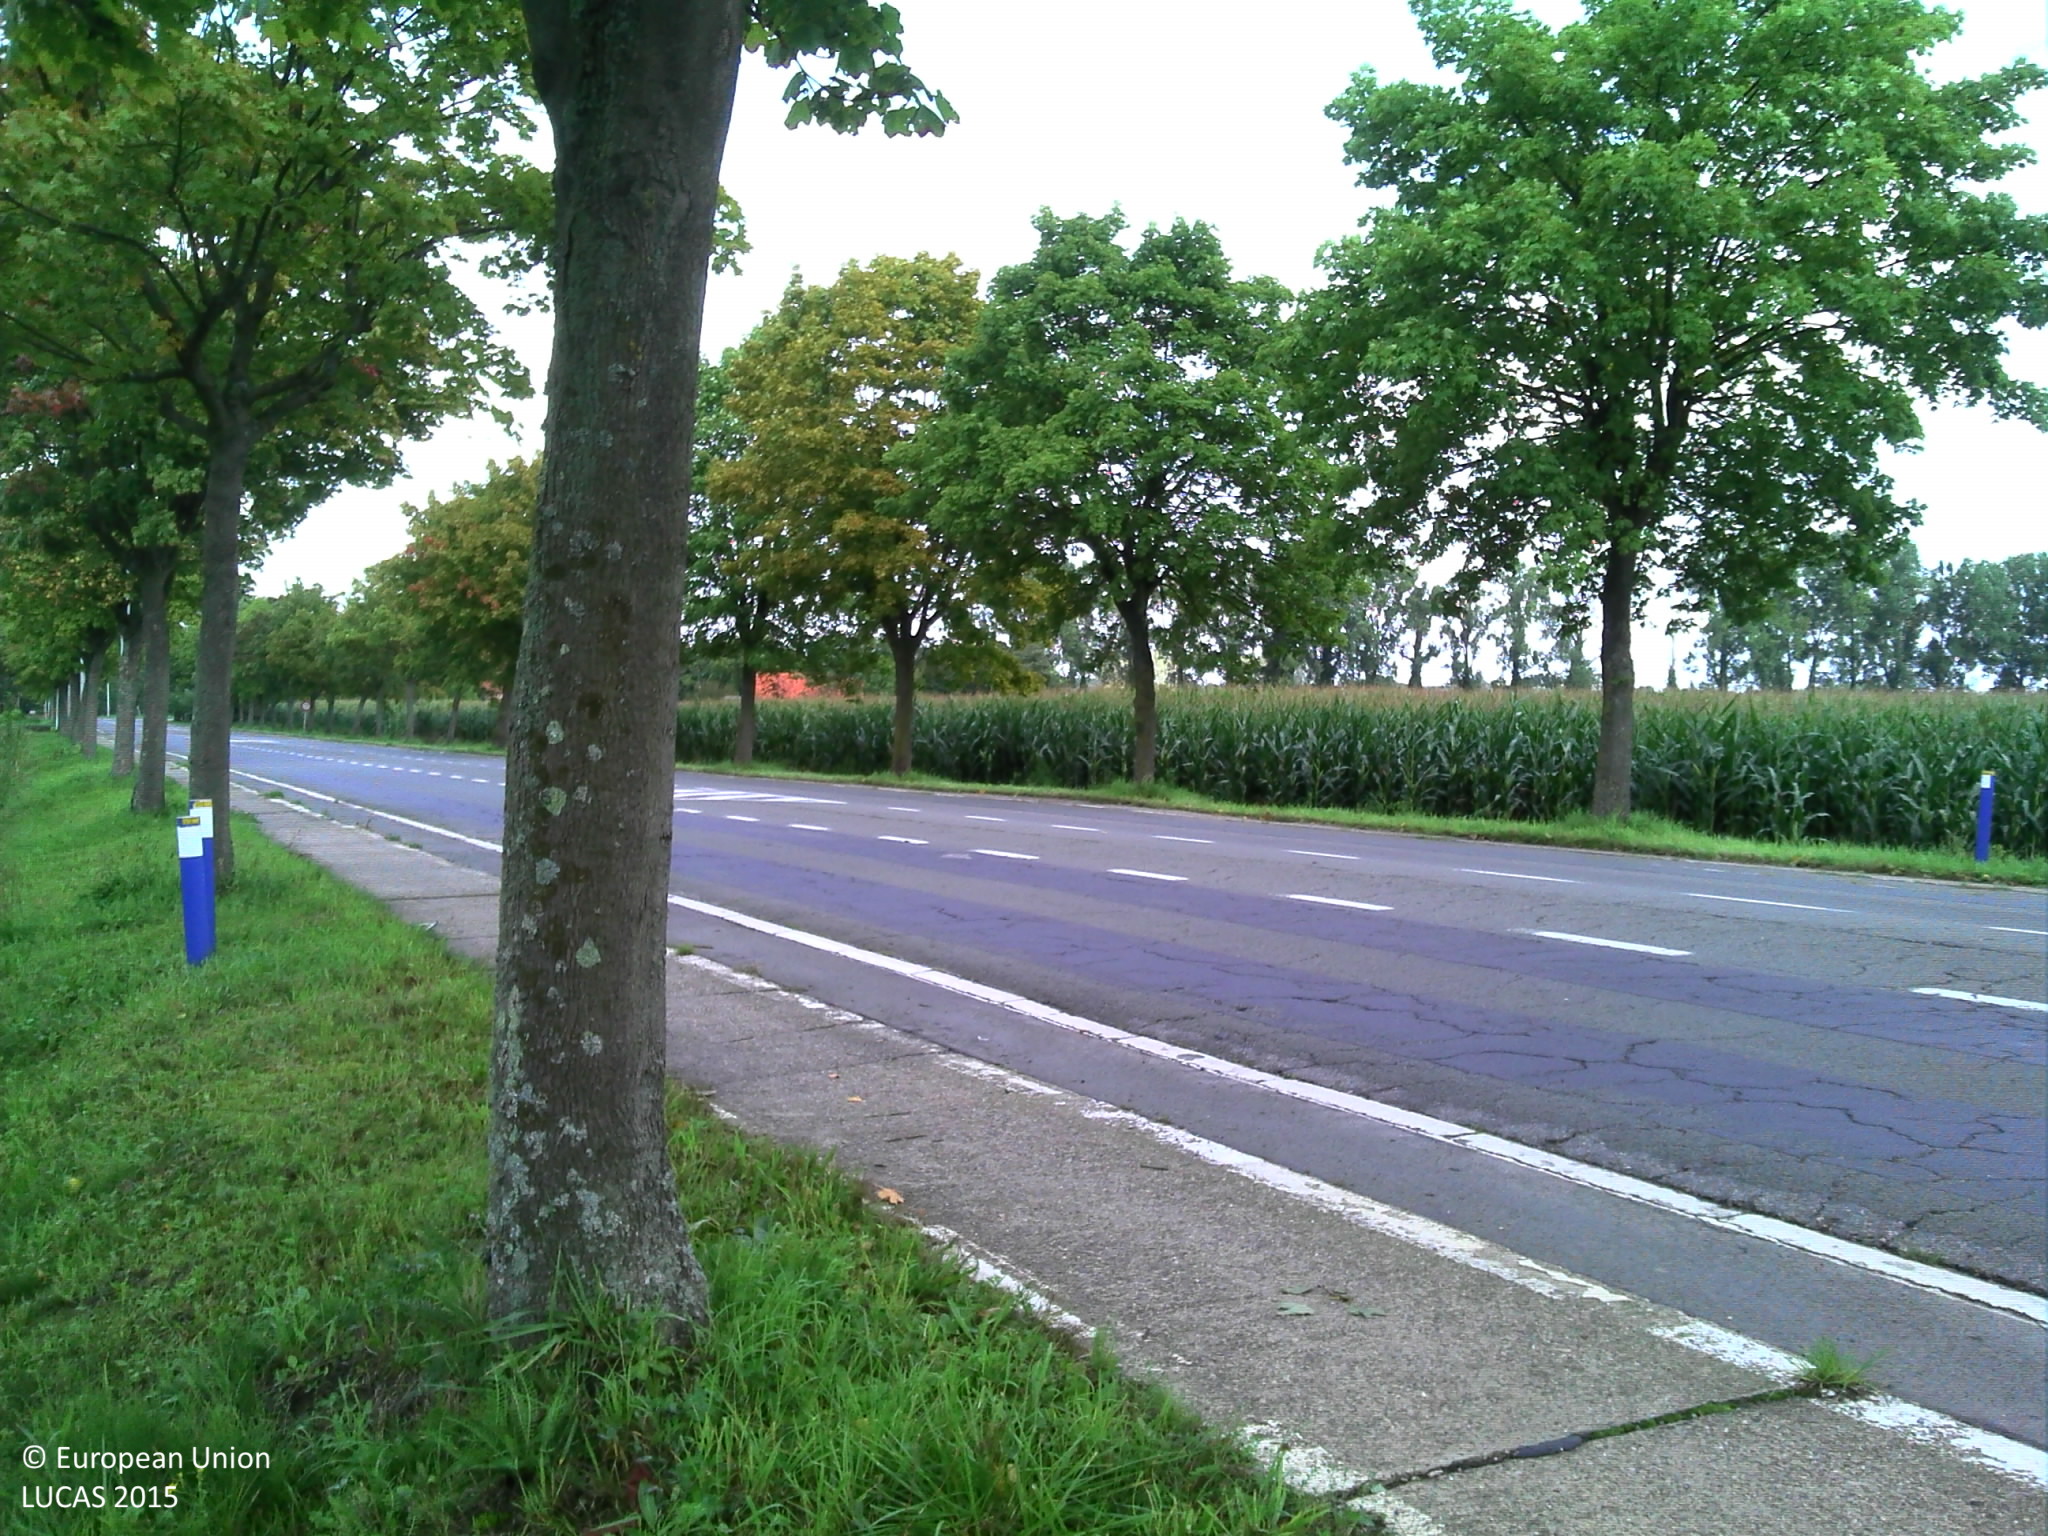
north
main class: Cropland
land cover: Maize
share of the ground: > 75 %
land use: Agriculture (excluding fallow land and kitchen gardens)
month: September
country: BE
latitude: 51.1464
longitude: 4.4062
